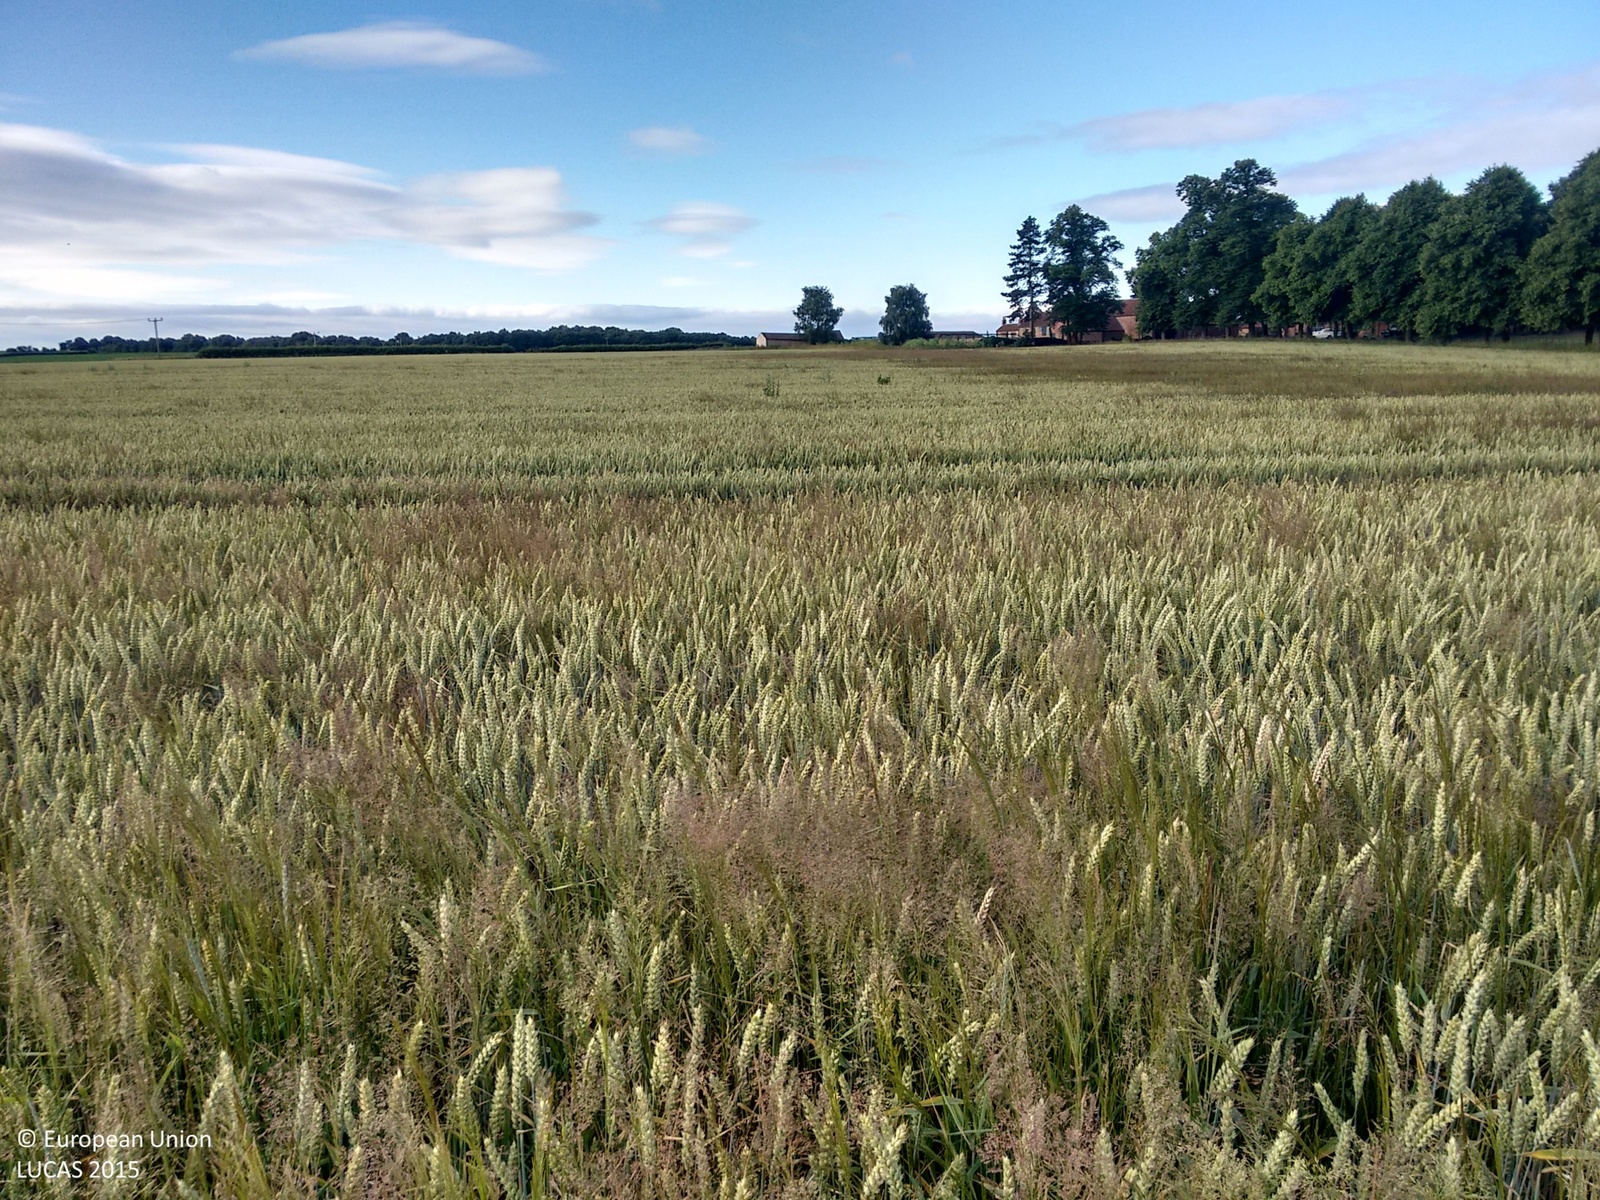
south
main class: Cropland
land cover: Common wheat
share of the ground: > 75 %
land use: Agriculture (excluding fallow land and kitchen gardens)
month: July
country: GB
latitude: 53.3915
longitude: -0.9751
